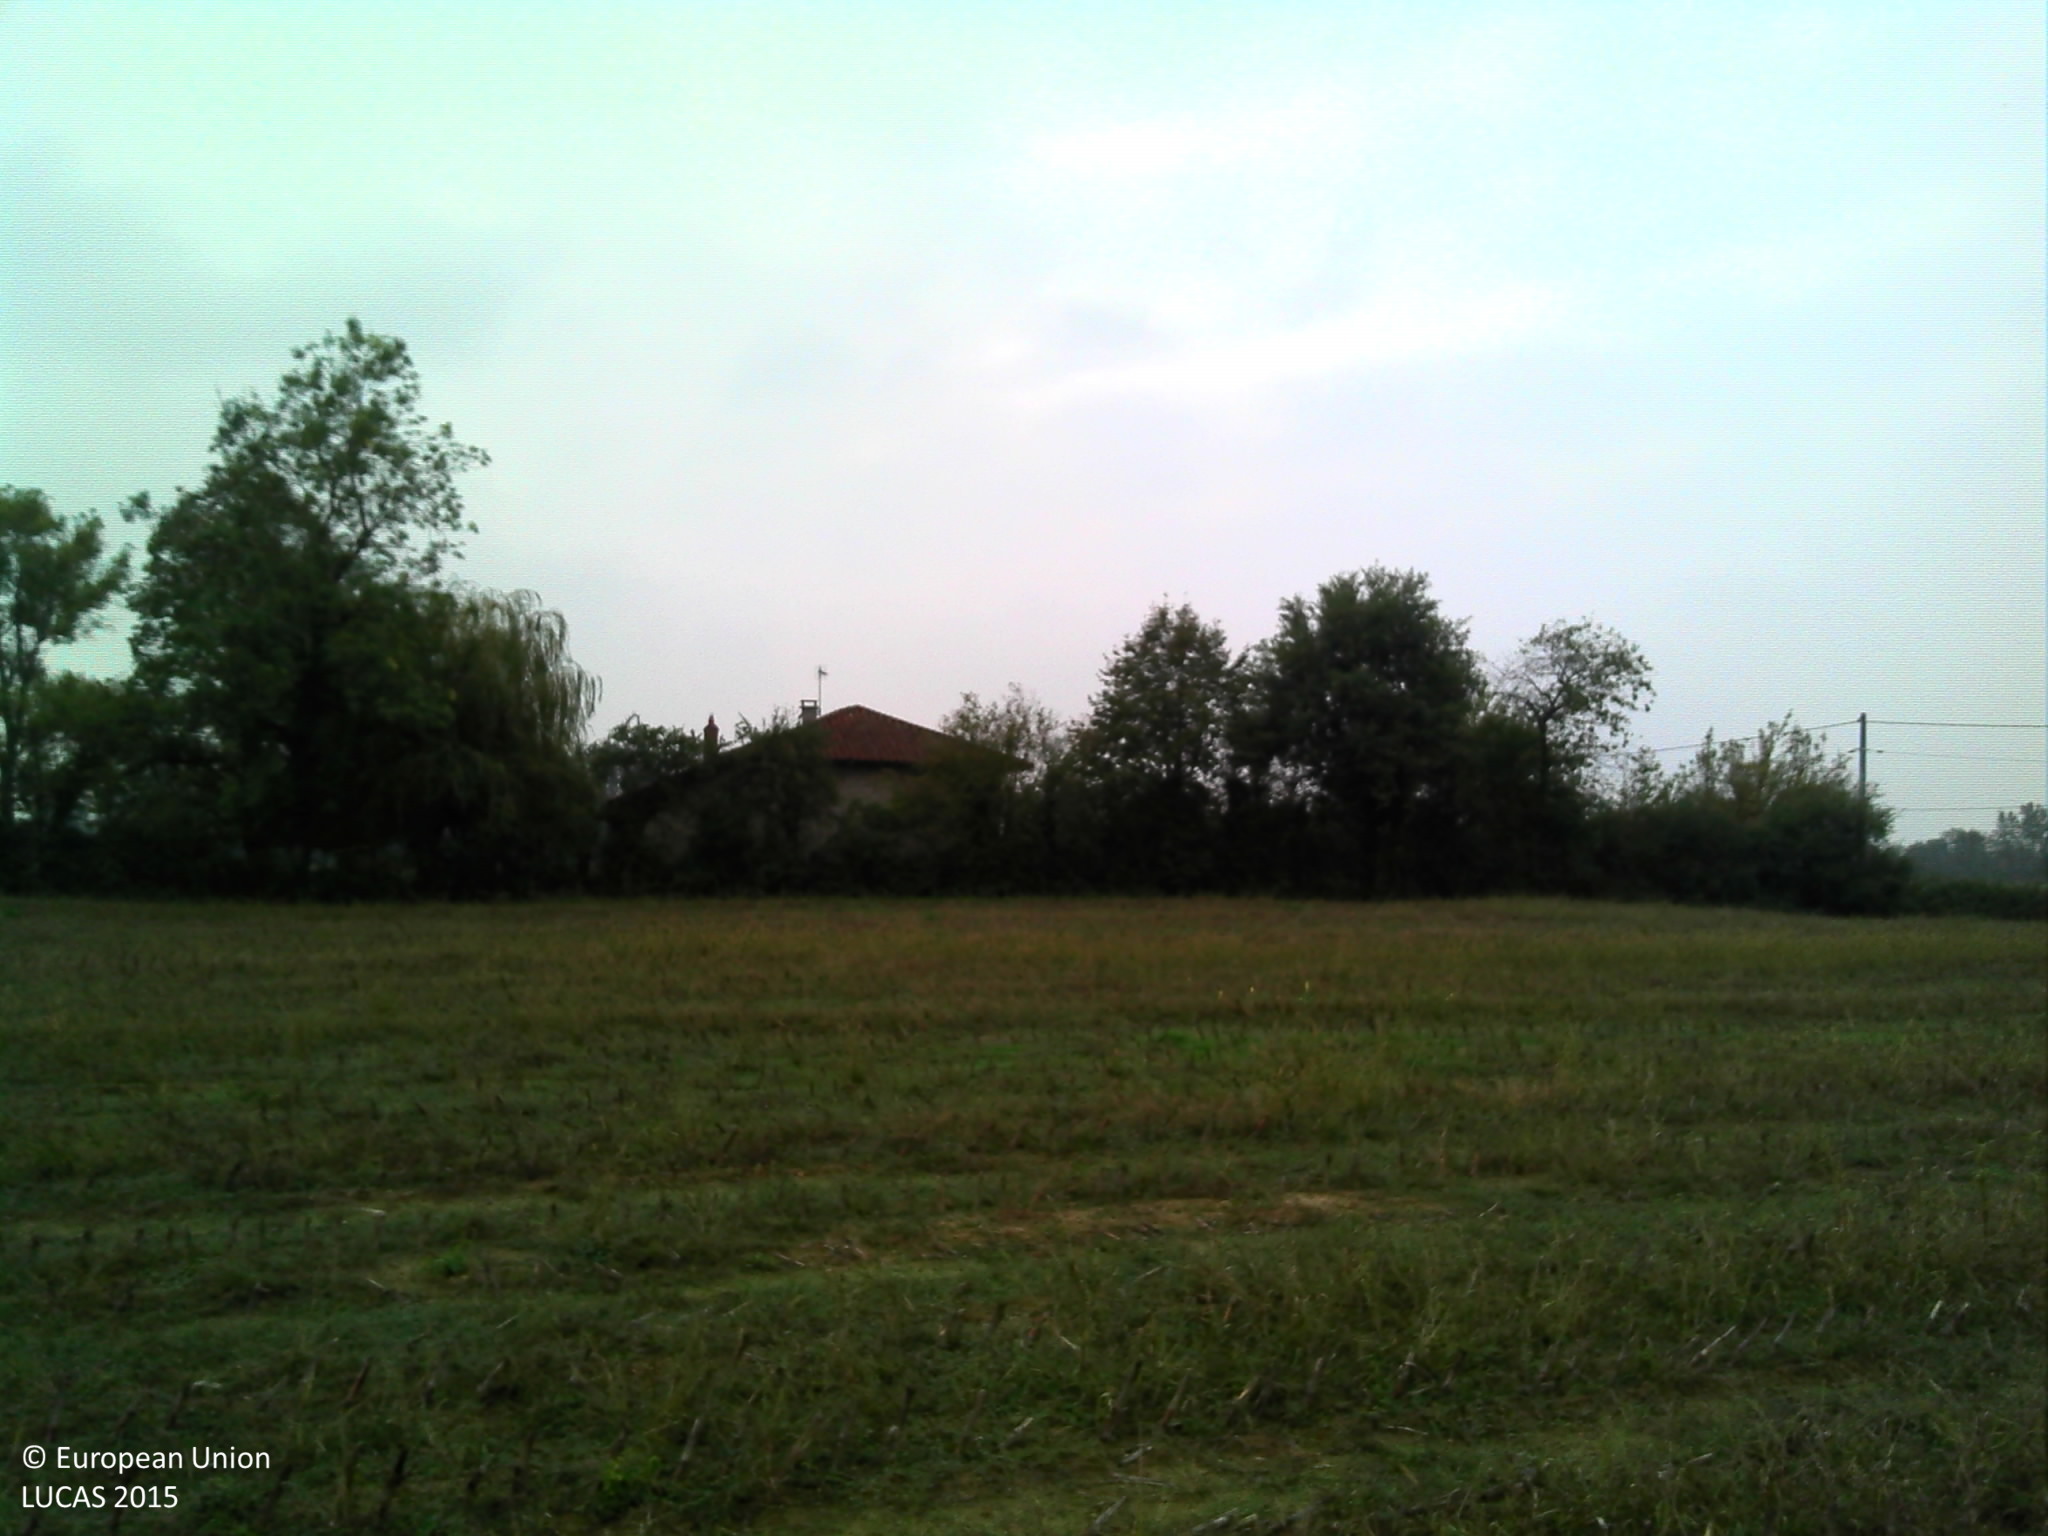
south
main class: Cropland
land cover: Maize
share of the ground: < 10 %
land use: Agriculture (excluding fallow land and kitchen gardens)
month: October
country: FR
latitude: 46.2947
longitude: 5.1346
